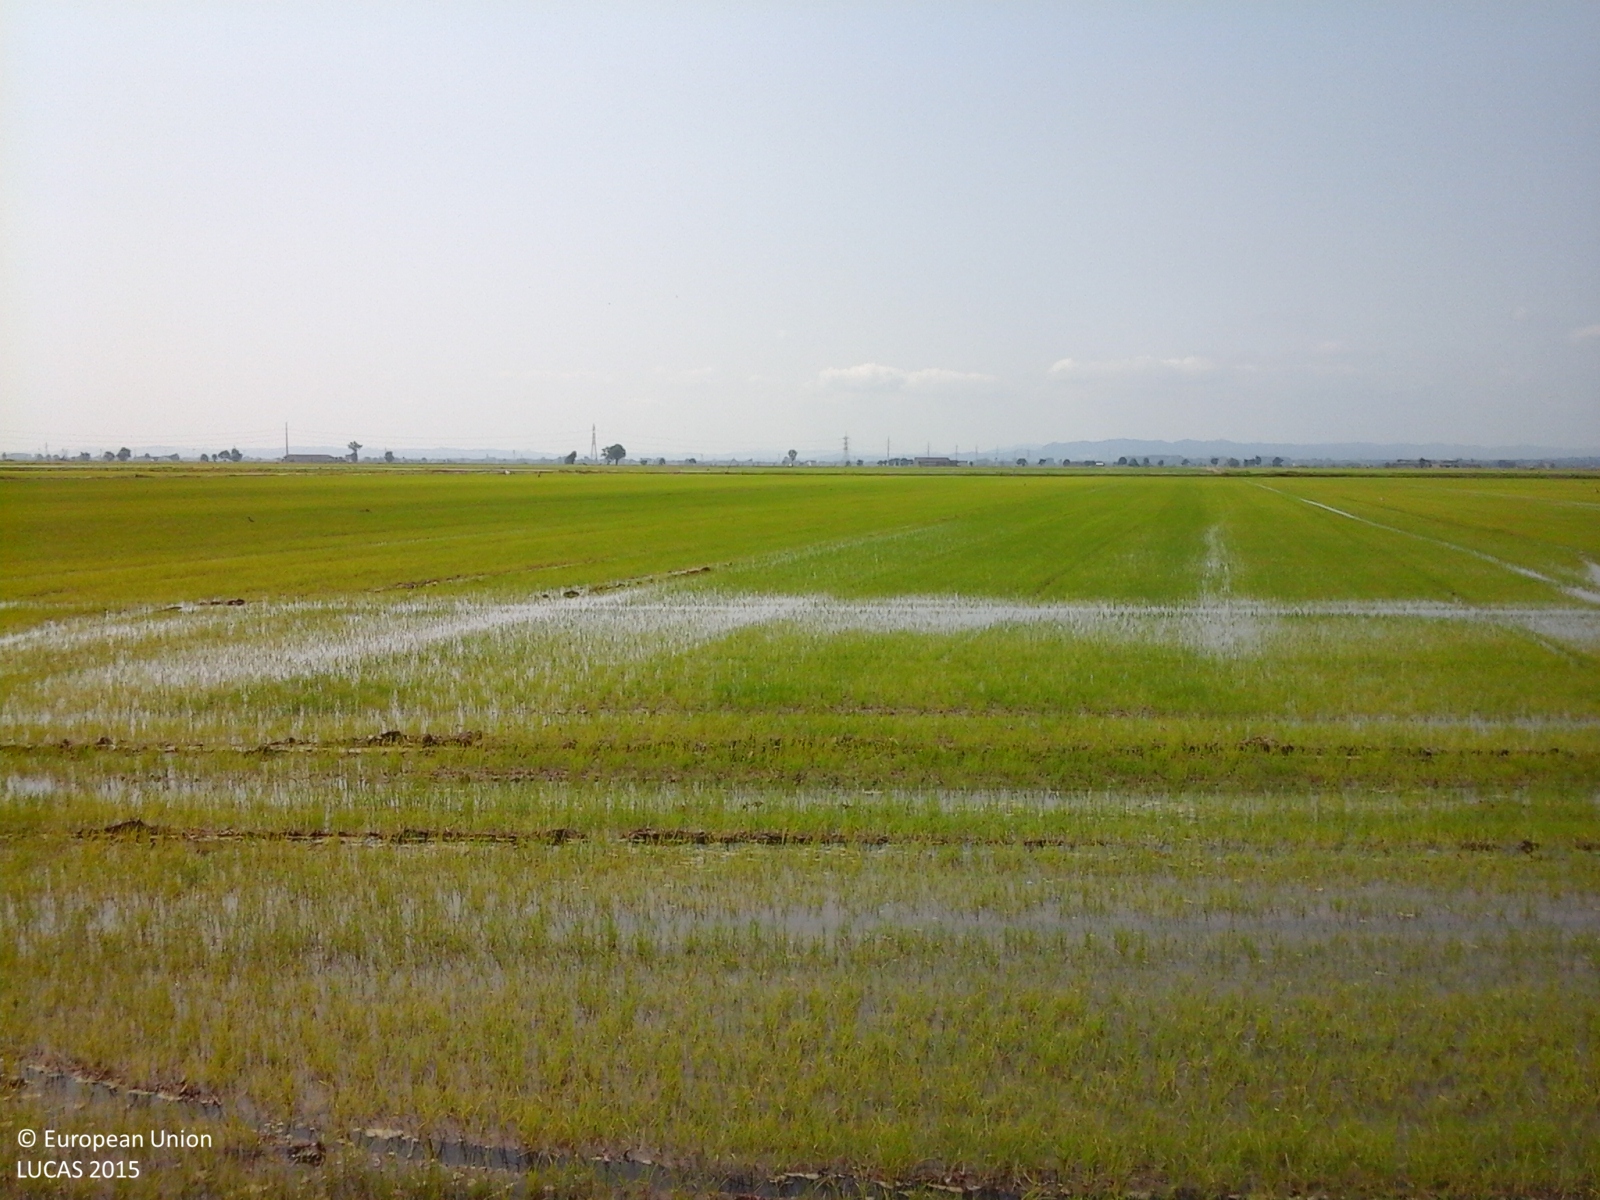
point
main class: Cropland
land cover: Rice
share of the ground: 50 - 75 %
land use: Agriculture (excluding fallow land and kitchen gardens)
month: May
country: IT
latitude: 45.2925
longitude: 8.3071
